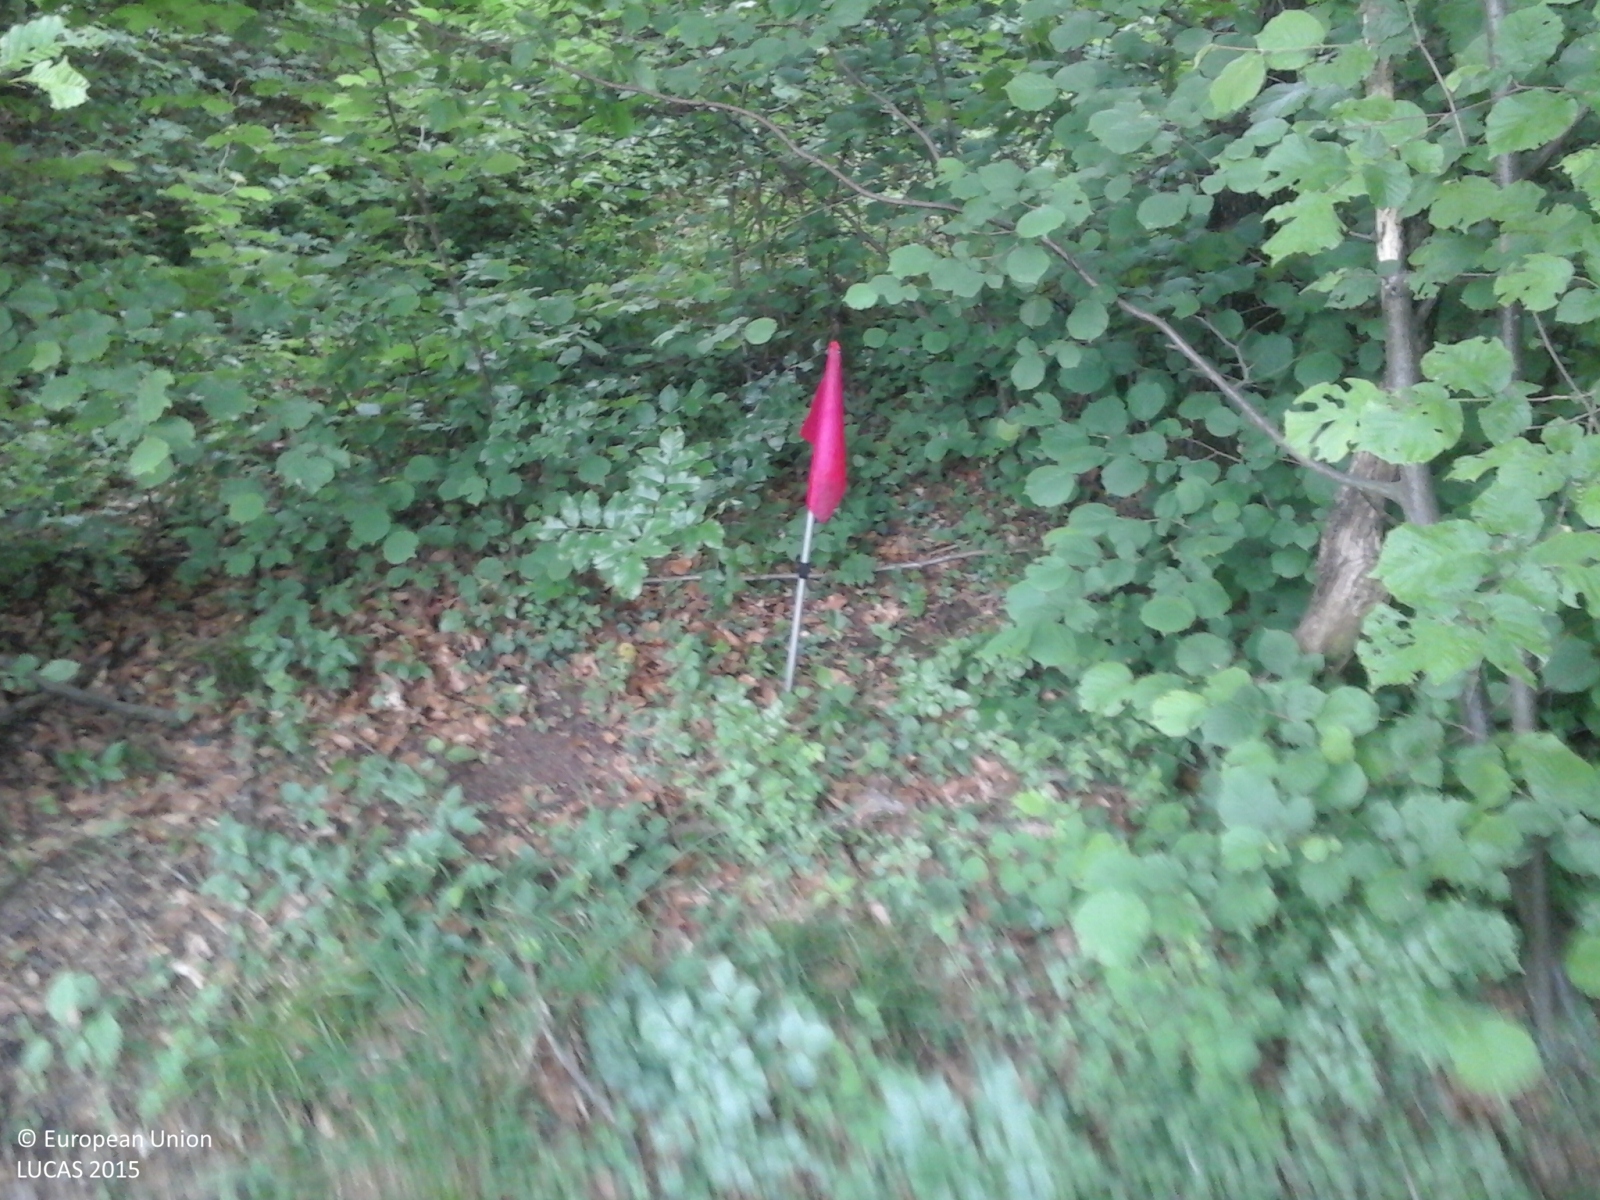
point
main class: Woodland
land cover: Broadleaved woodland
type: mesophytic deciduous forest
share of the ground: > 75 %
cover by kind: broadleaved forest trees 60 %, shrubs 40 %
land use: Forestry
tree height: > 5 m
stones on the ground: < 10 %
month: May
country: IT
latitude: 45.8424
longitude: 10.9642
